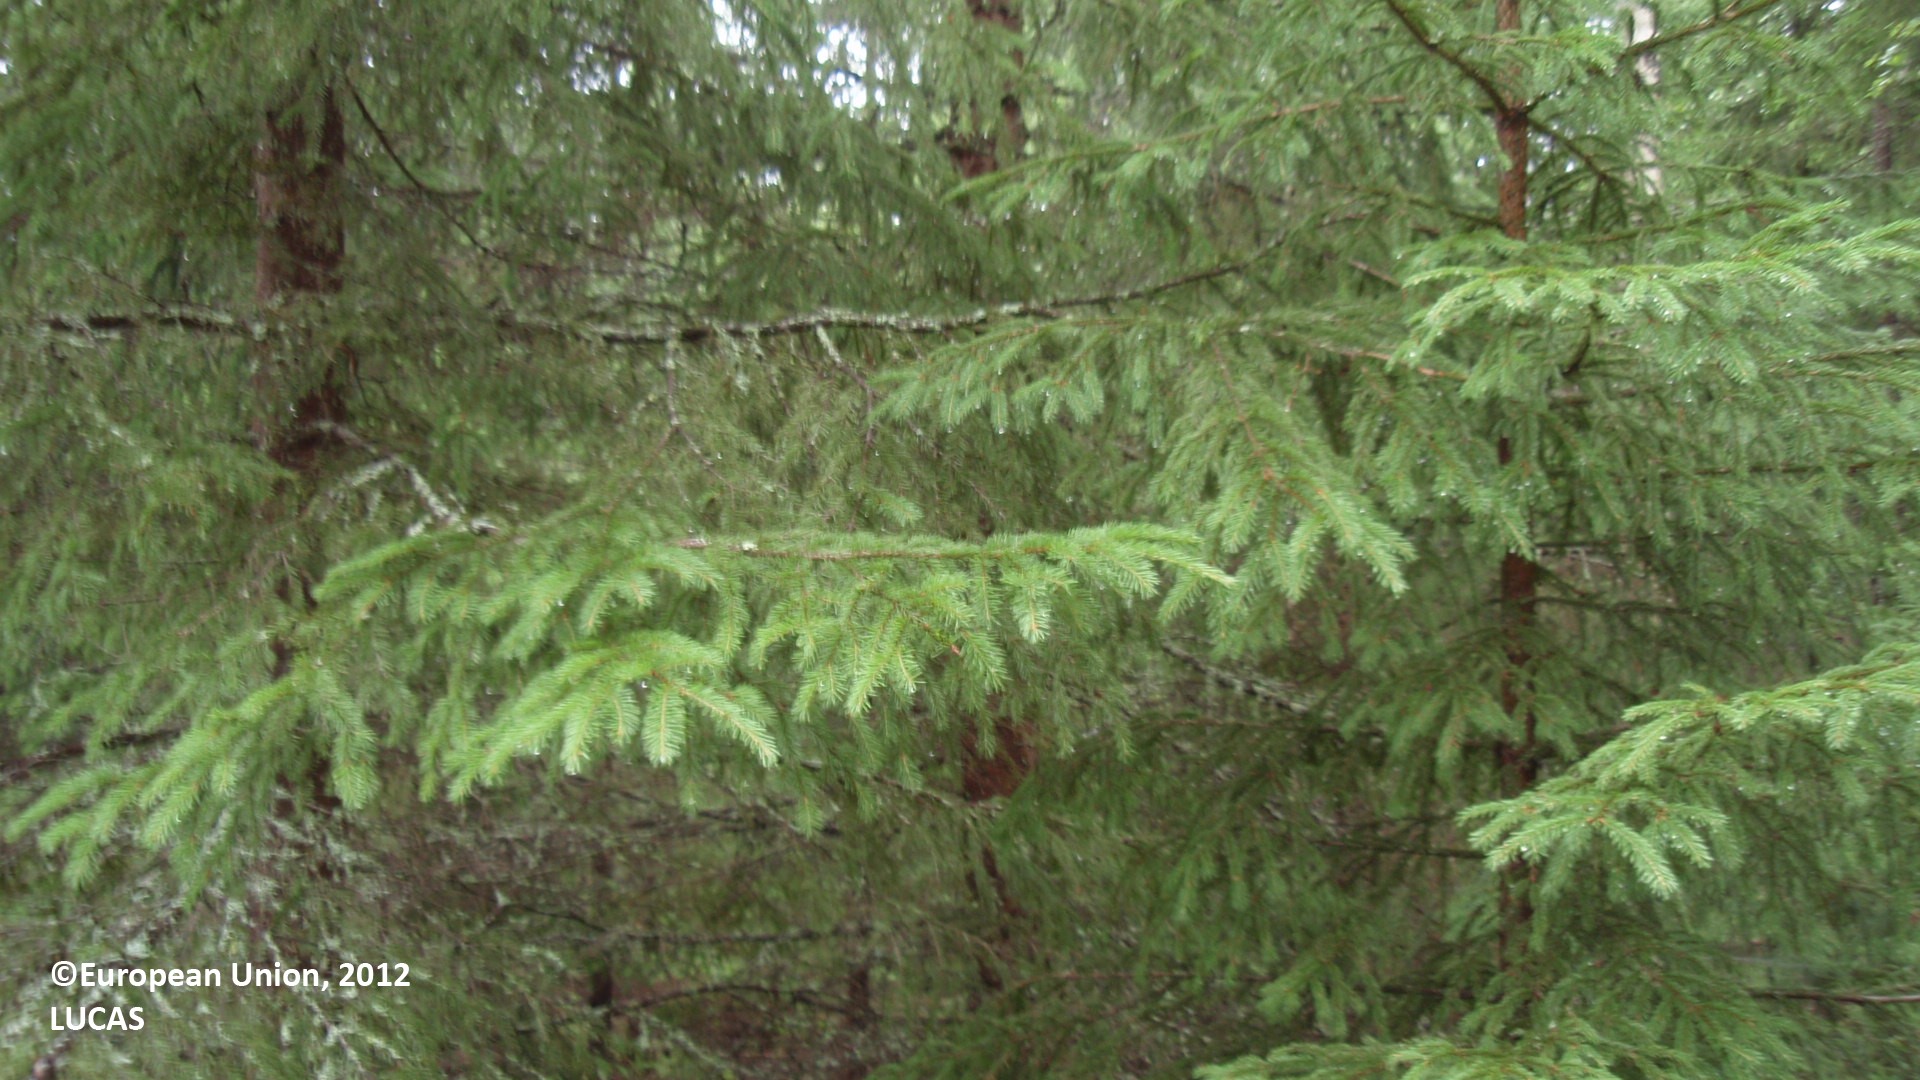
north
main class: Woodland
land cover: Spruce dominated mixed woodland
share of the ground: > 75 %
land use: Forestry
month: July
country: FI
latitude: 61.5852
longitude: 27.2553
